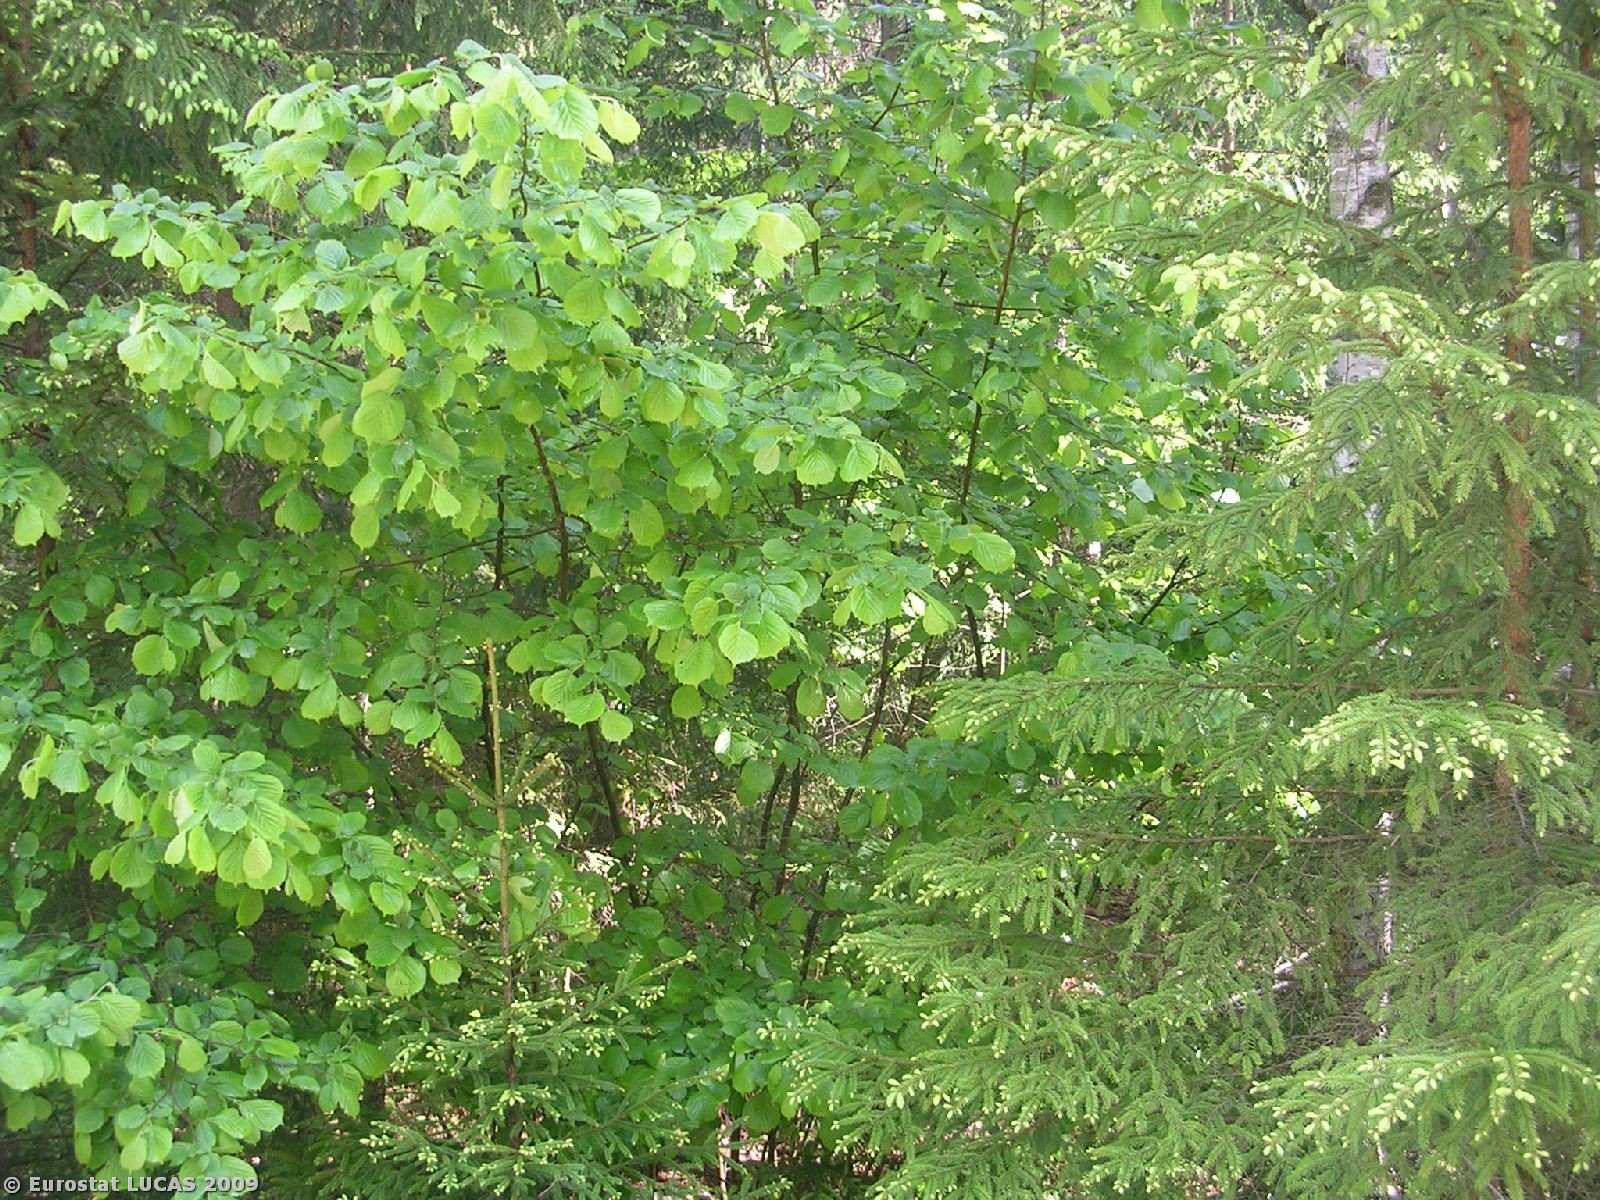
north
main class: Woodland
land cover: Mixed woodland
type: hemiboreal forest and nemoral coniferous forest and mixed broadleaved-coniferous forest
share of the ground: > 75 %
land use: Nature reserves
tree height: > 5 m
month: May
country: PL
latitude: 53.2571
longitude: 23.3775
